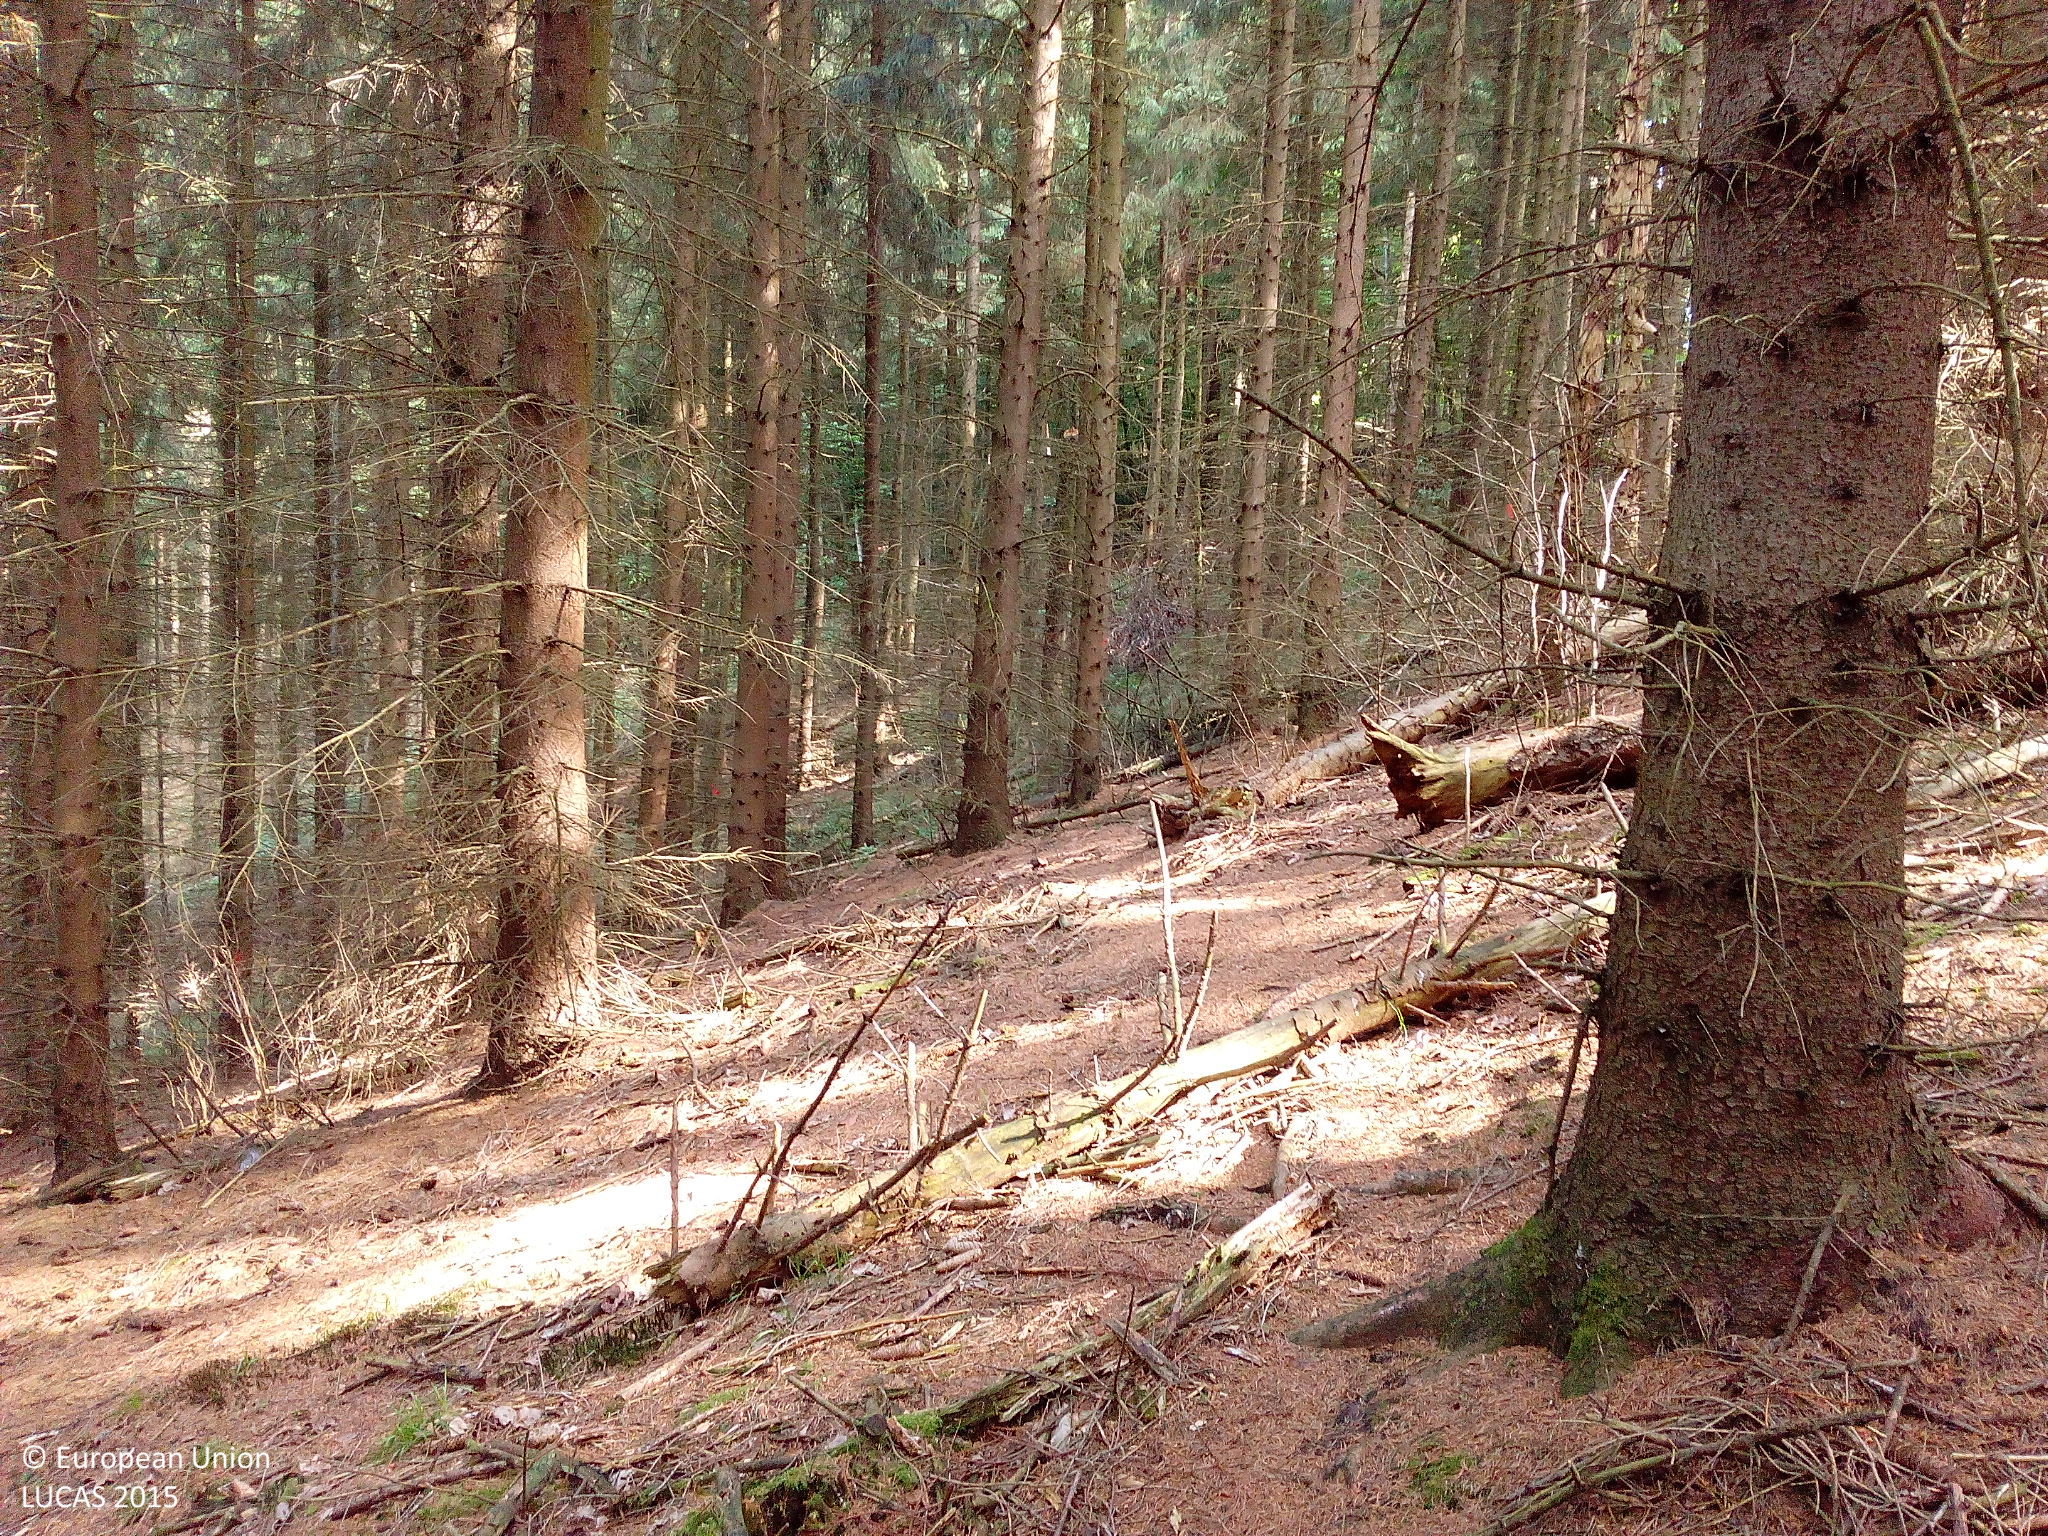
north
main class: Woodland
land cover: Spruce dominated coniferous woodland
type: hemiboreal forest and nemoral coniferous forest and mixed broadleaved-coniferous forest
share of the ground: > 75 %
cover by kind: coniferous forest trees 95 %, unconsolidated bare surface 5 %
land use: Forestry
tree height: > 5 m
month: July
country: DE
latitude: 51.0832
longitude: 9.9572
